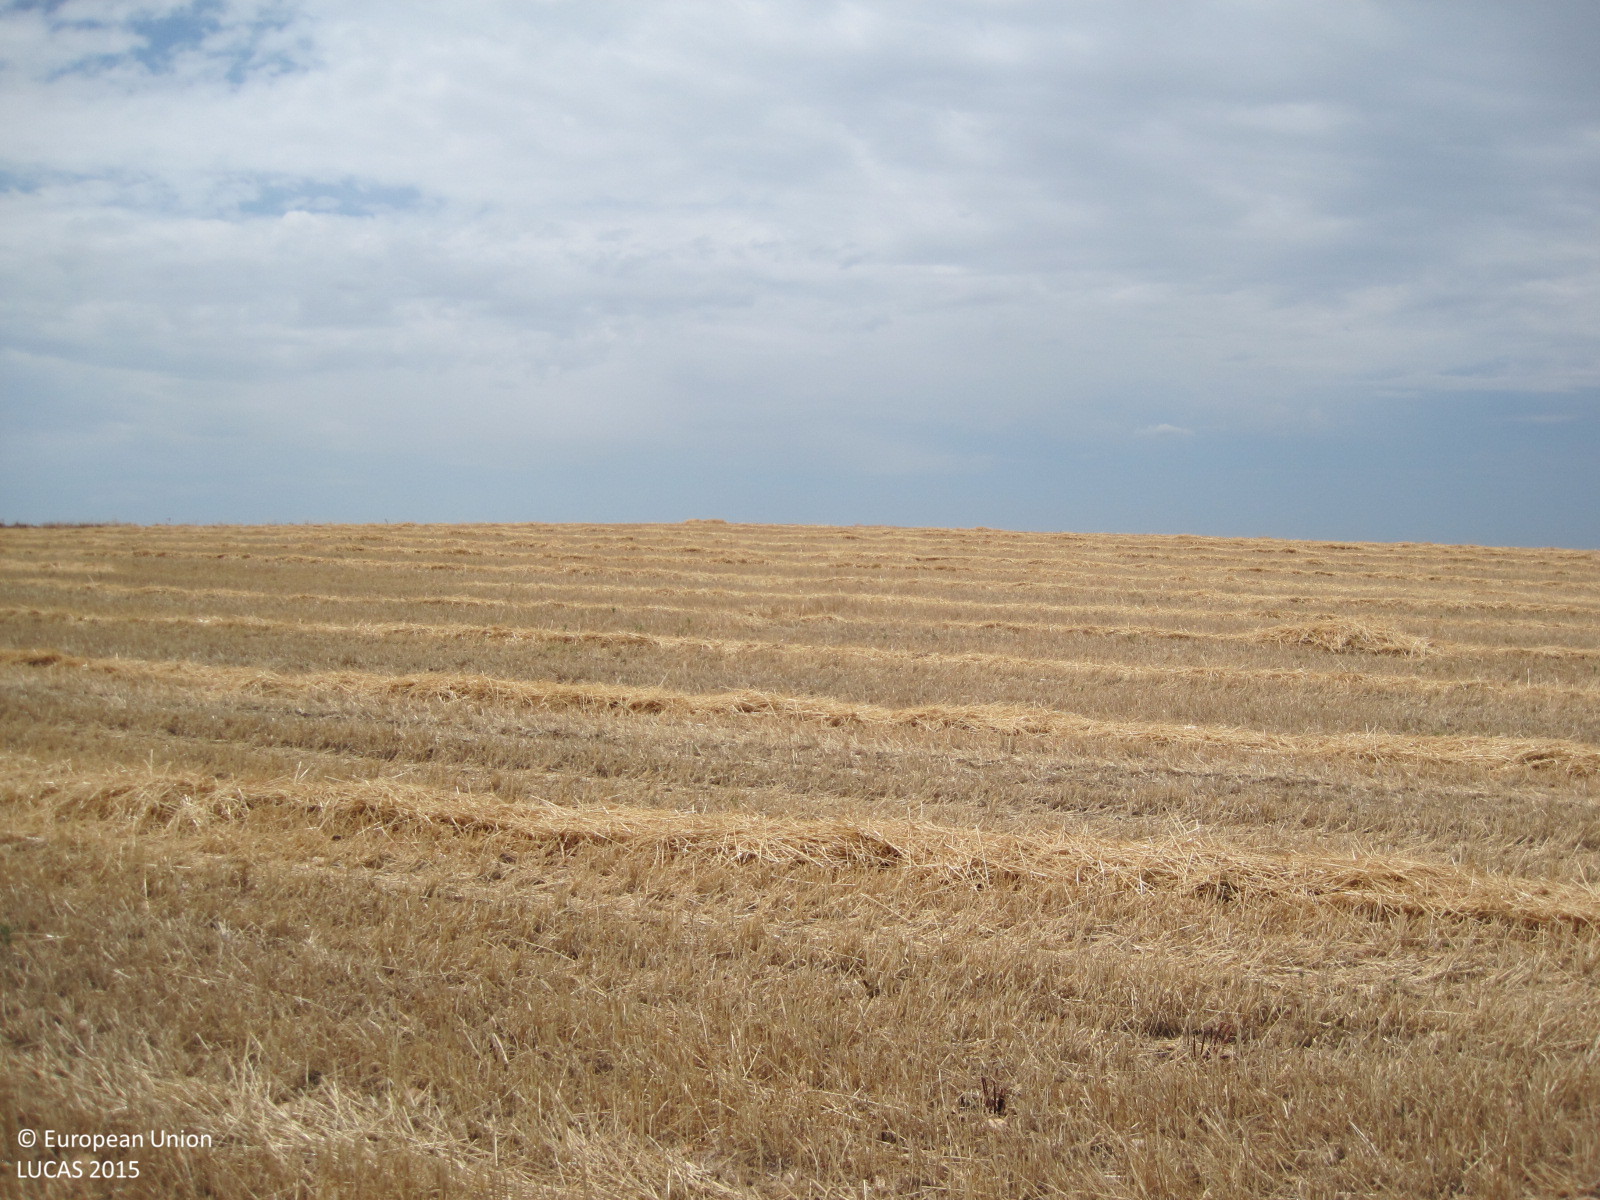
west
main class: Cropland
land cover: Common wheat
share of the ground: < 10 %
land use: Agriculture (excluding fallow land and kitchen gardens)
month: July
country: ES
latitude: 40.1027
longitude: -4.3660
